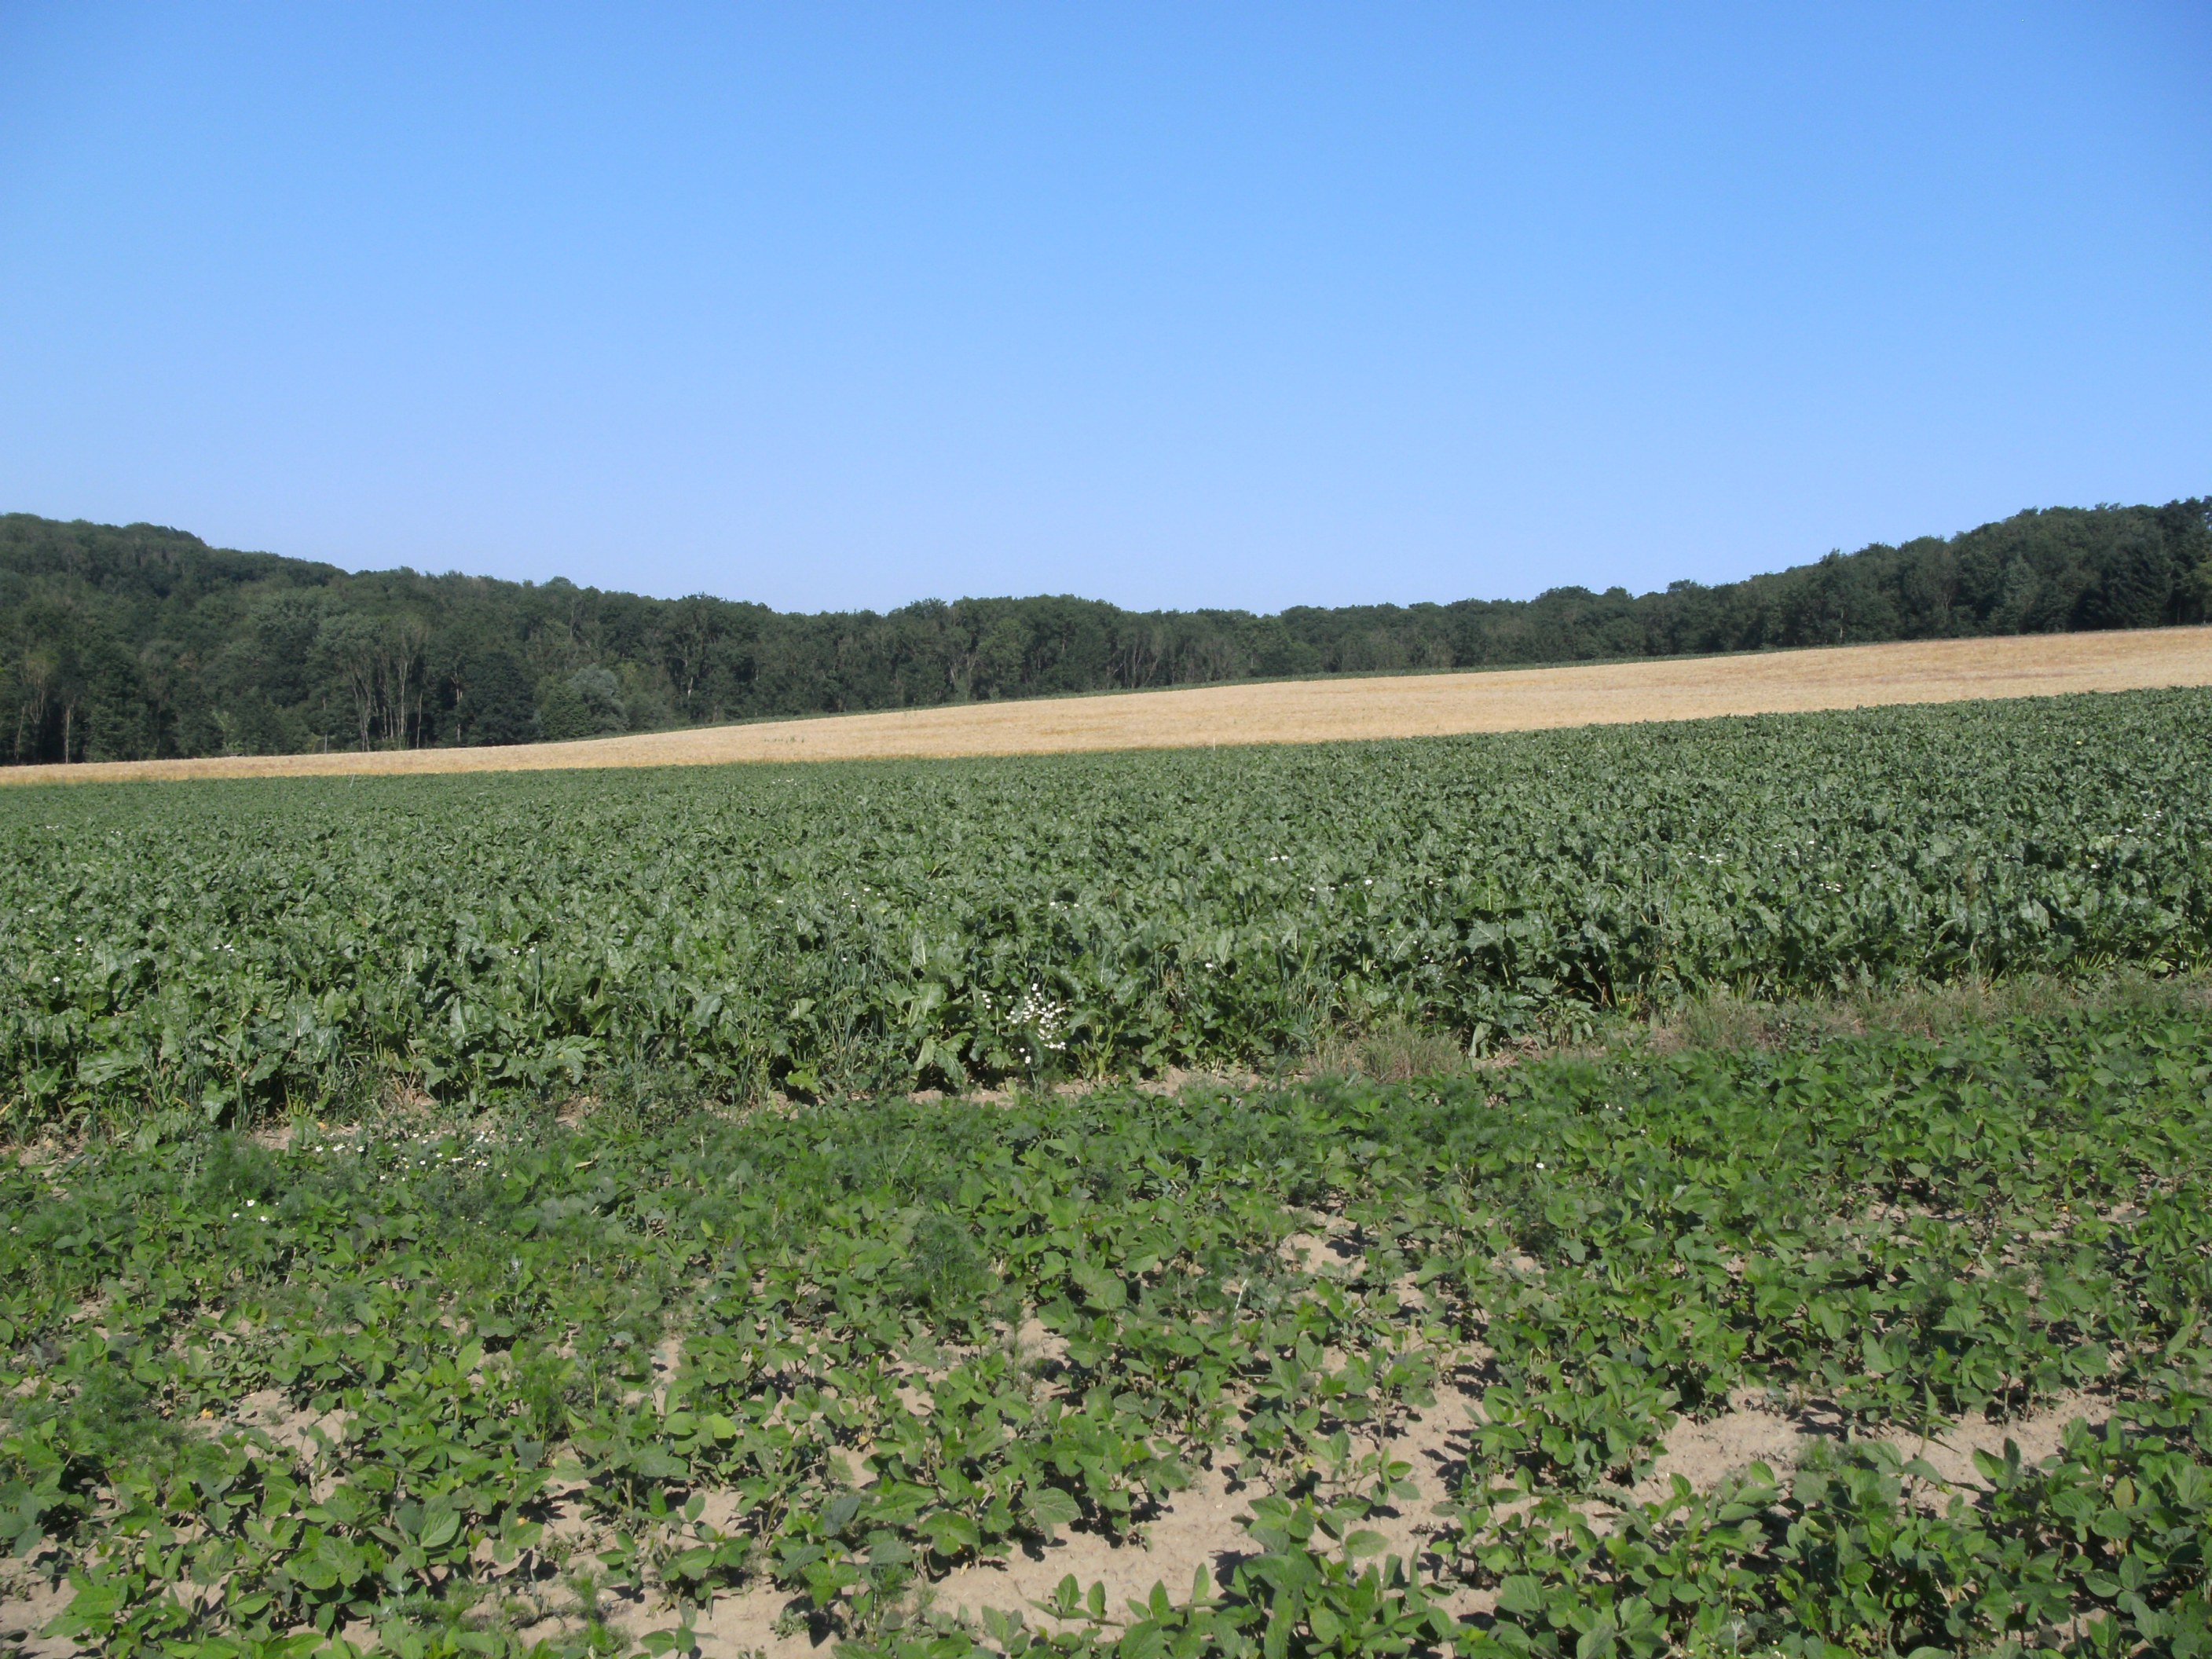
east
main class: Cropland
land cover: Soya
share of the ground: > 75 %
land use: Agriculture (excluding fallow land and kitchen gardens)
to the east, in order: Soya; Sugar beet; Ditches and canals; Grass margins; Paved roads, cycling and walking lanes; Grass margins; Barley
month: July
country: AT
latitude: 48.2711
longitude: 14.1632
